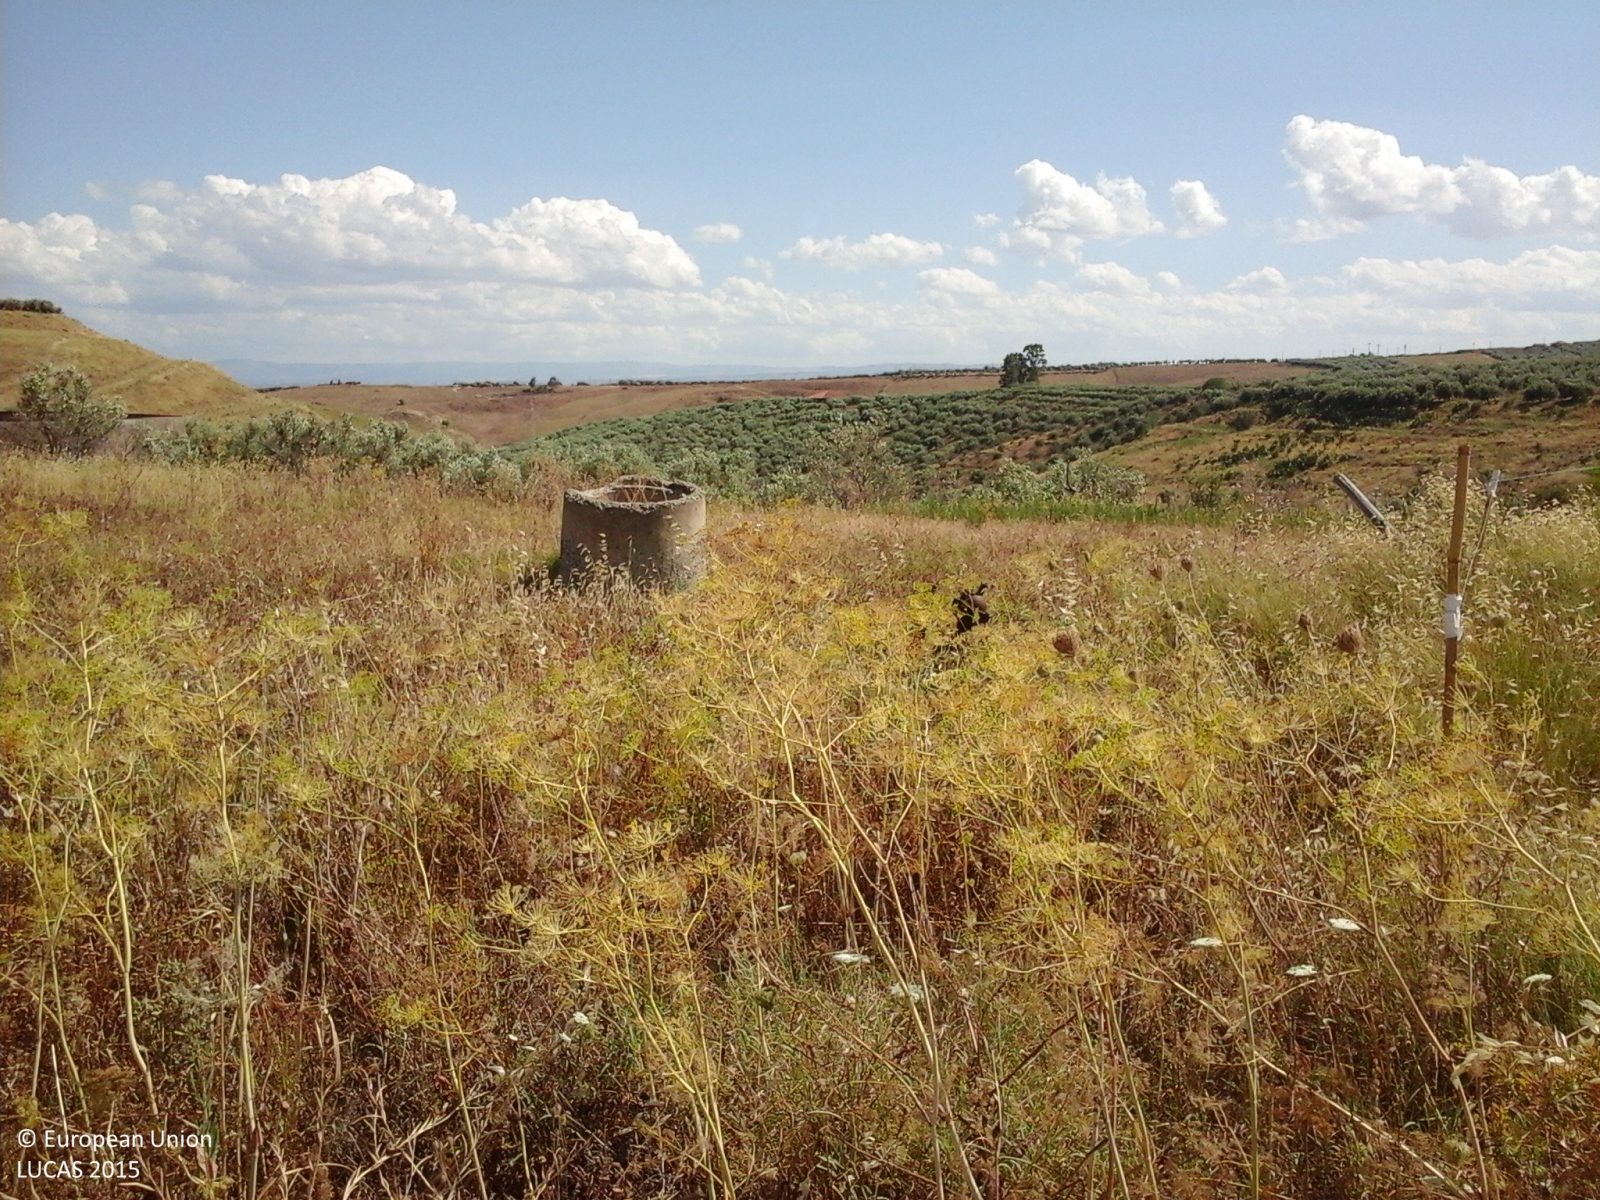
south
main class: Grassland
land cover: Grassland without tree/shrub cover
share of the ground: > 75 %
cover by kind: herbaceous plants 95 %, shrubs 5 %
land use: Agriculture (excluding fallow land and kitchen gardens)
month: June
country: IT
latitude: 37.5513
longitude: 14.8438
